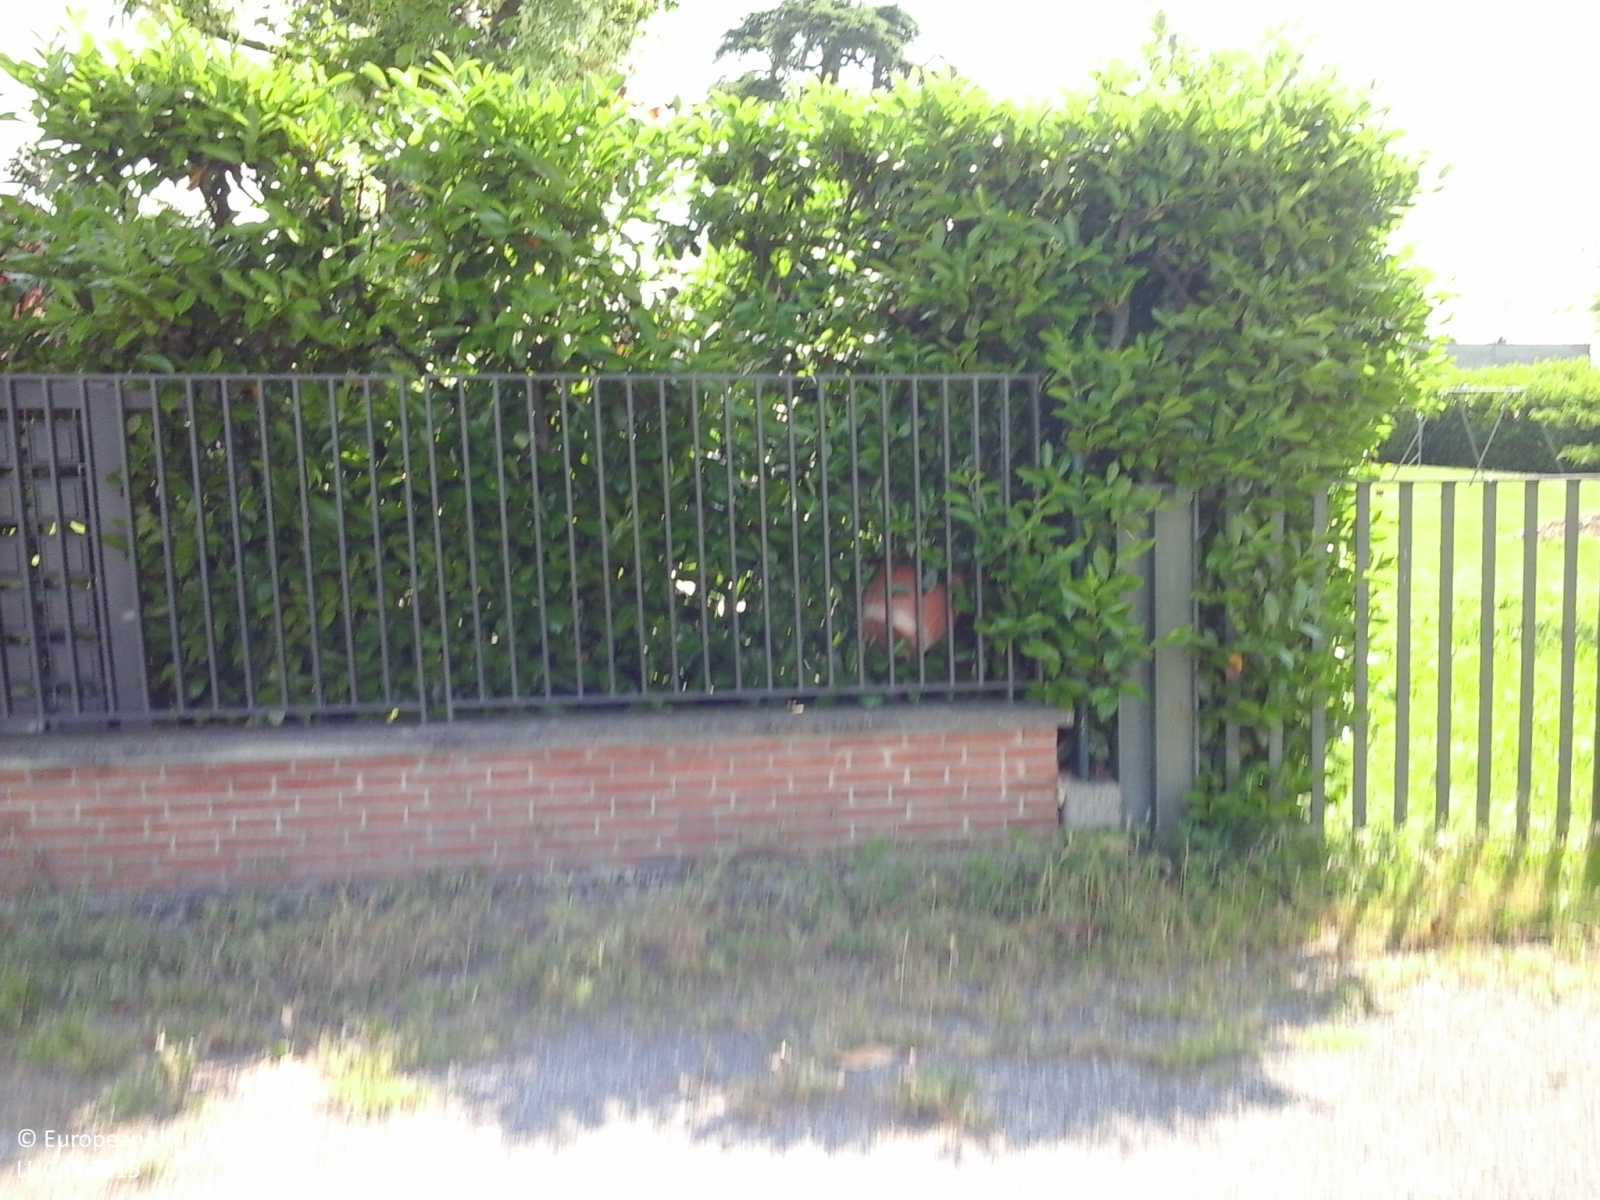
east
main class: Cropland
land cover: Temporary grasslands
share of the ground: > 75 %
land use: Agriculture (excluding fallow land and kitchen gardens)
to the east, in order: Temporary grasslands; Artificial constructions in urban areas
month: May
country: IT
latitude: 45.3962
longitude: 9.8597
